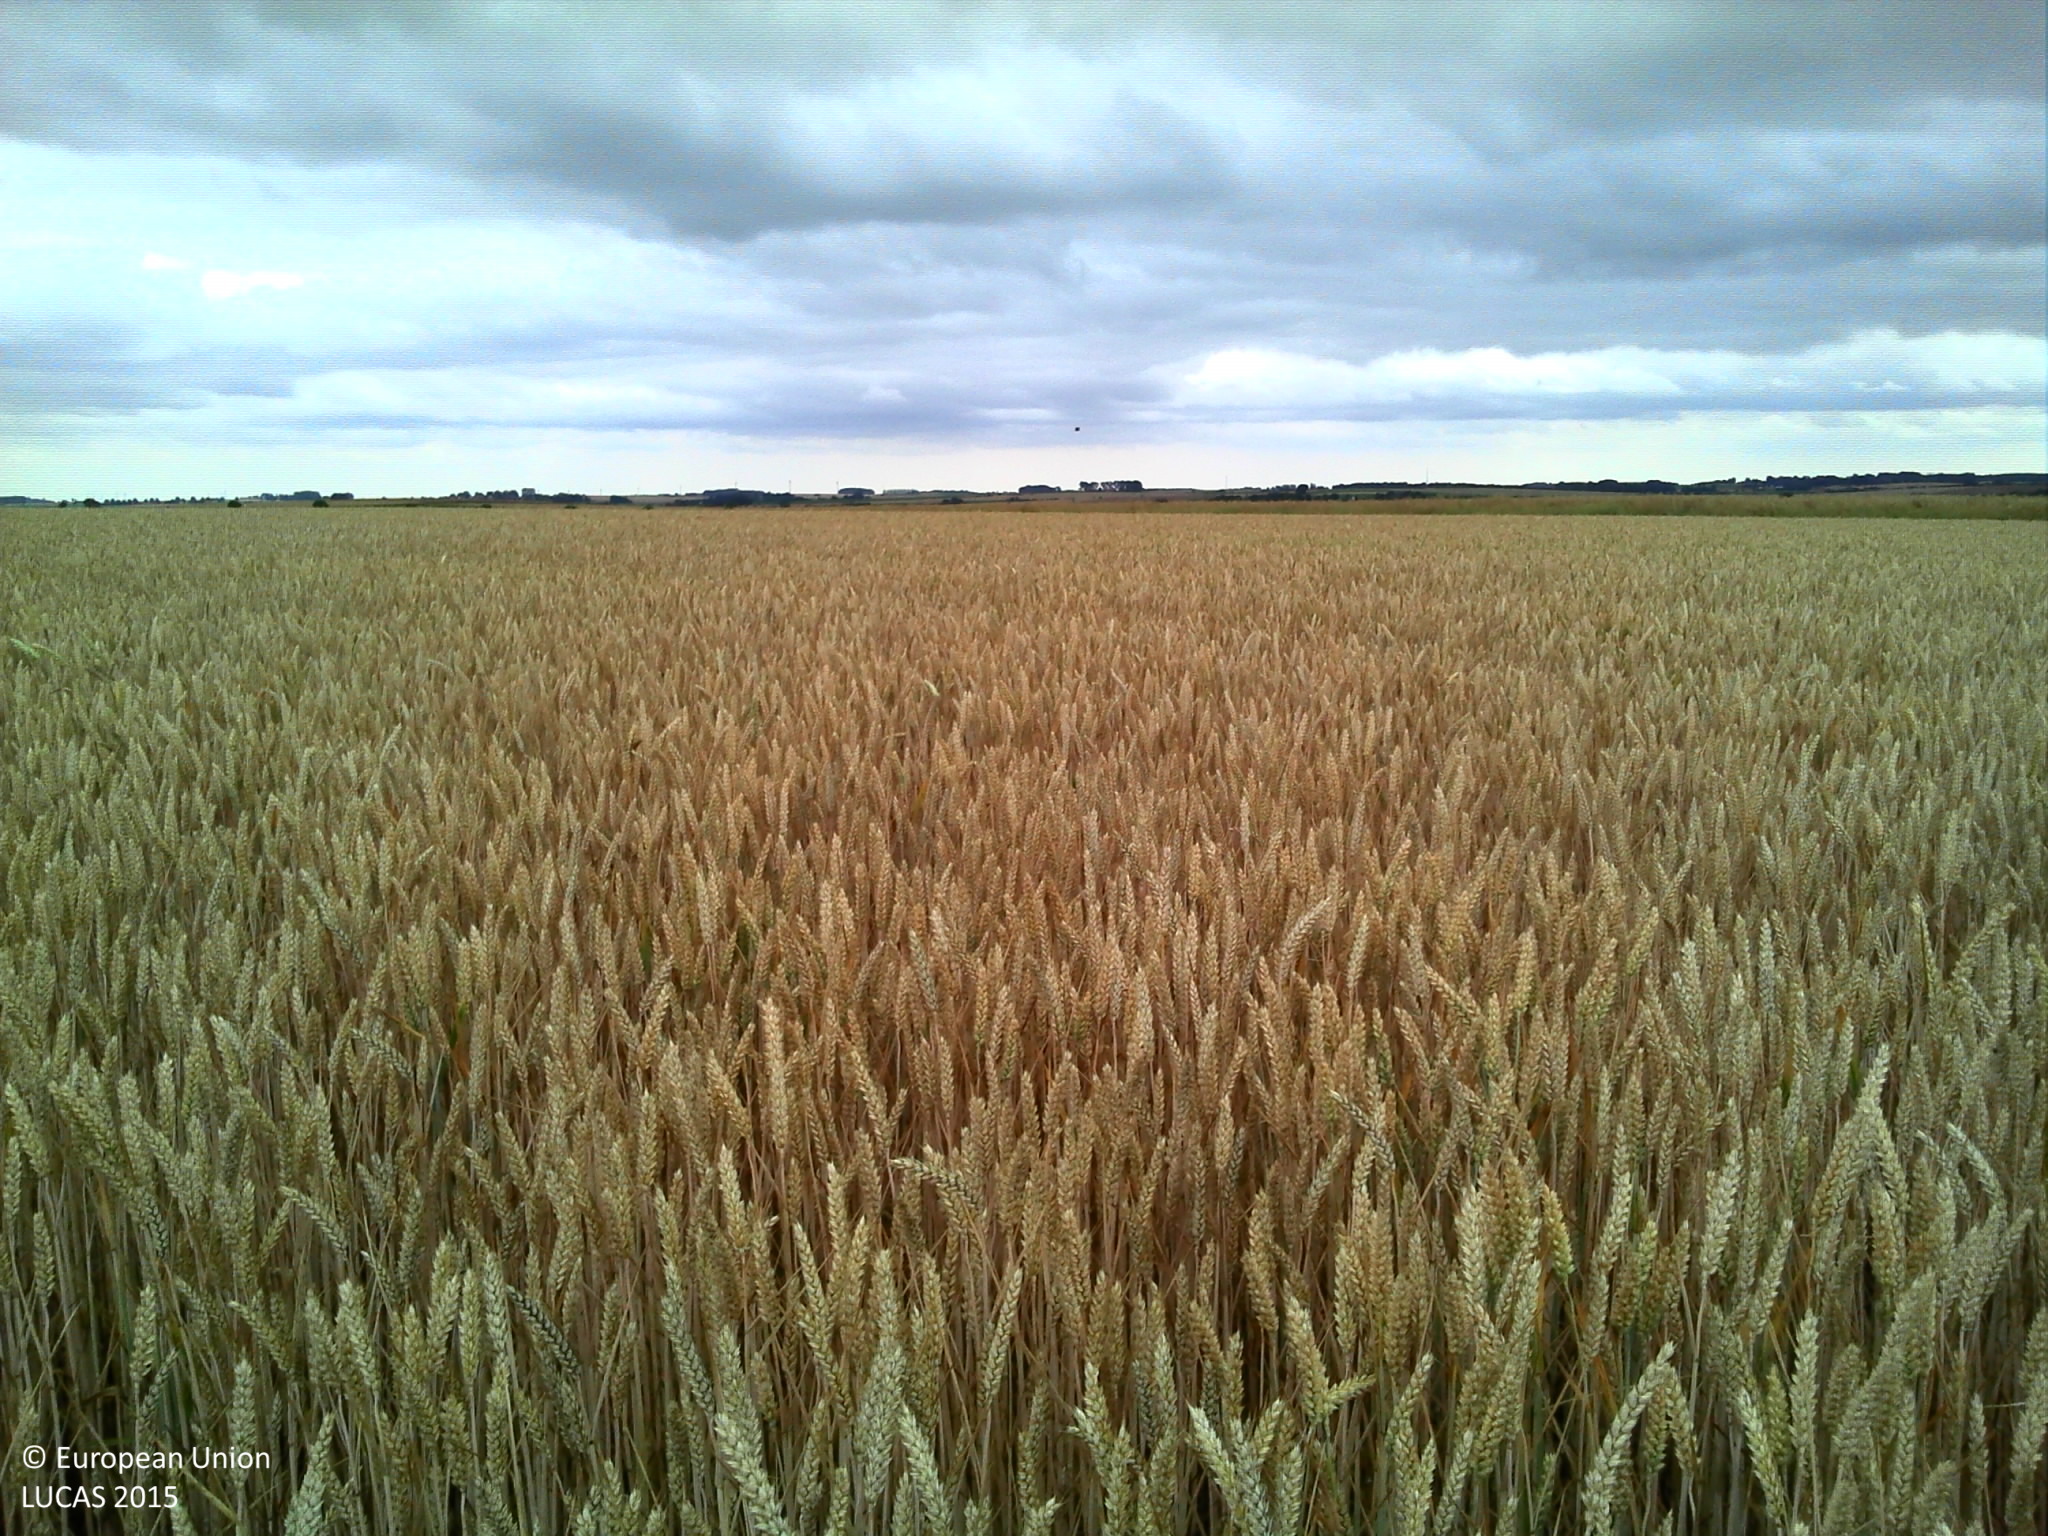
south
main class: Cropland
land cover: Common wheat
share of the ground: > 75 %
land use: Agriculture (excluding fallow land and kitchen gardens)
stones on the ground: < 10 %
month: July
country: FR
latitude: 50.0365
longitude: 3.2198
